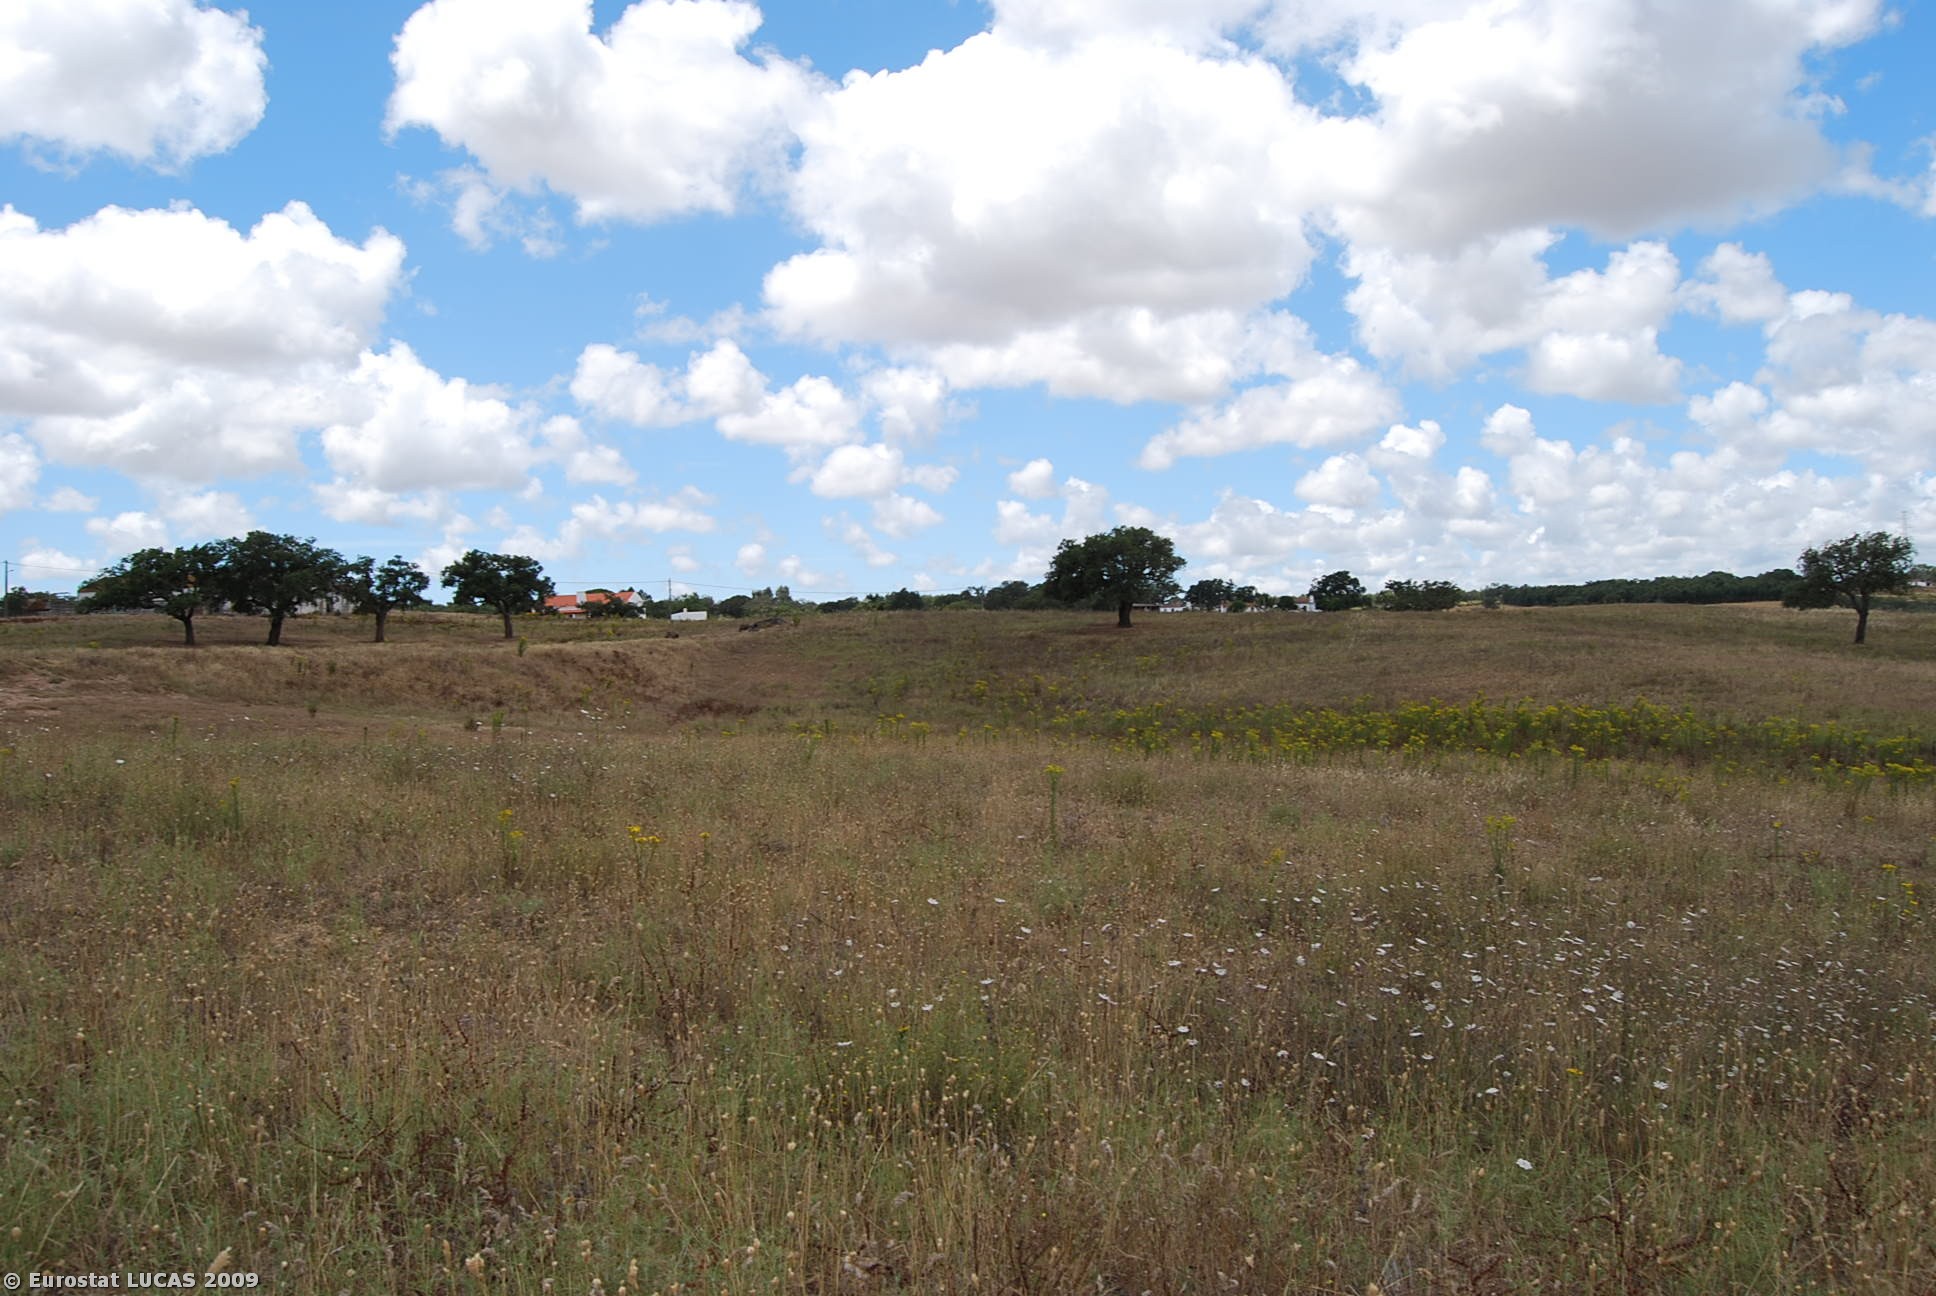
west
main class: Grassland
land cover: Grassland without tree/shrub cover
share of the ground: > 75 %
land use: Agriculture (excluding fallow land and kitchen gardens)
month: June
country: PT
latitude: 37.9029
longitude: -8.5693
